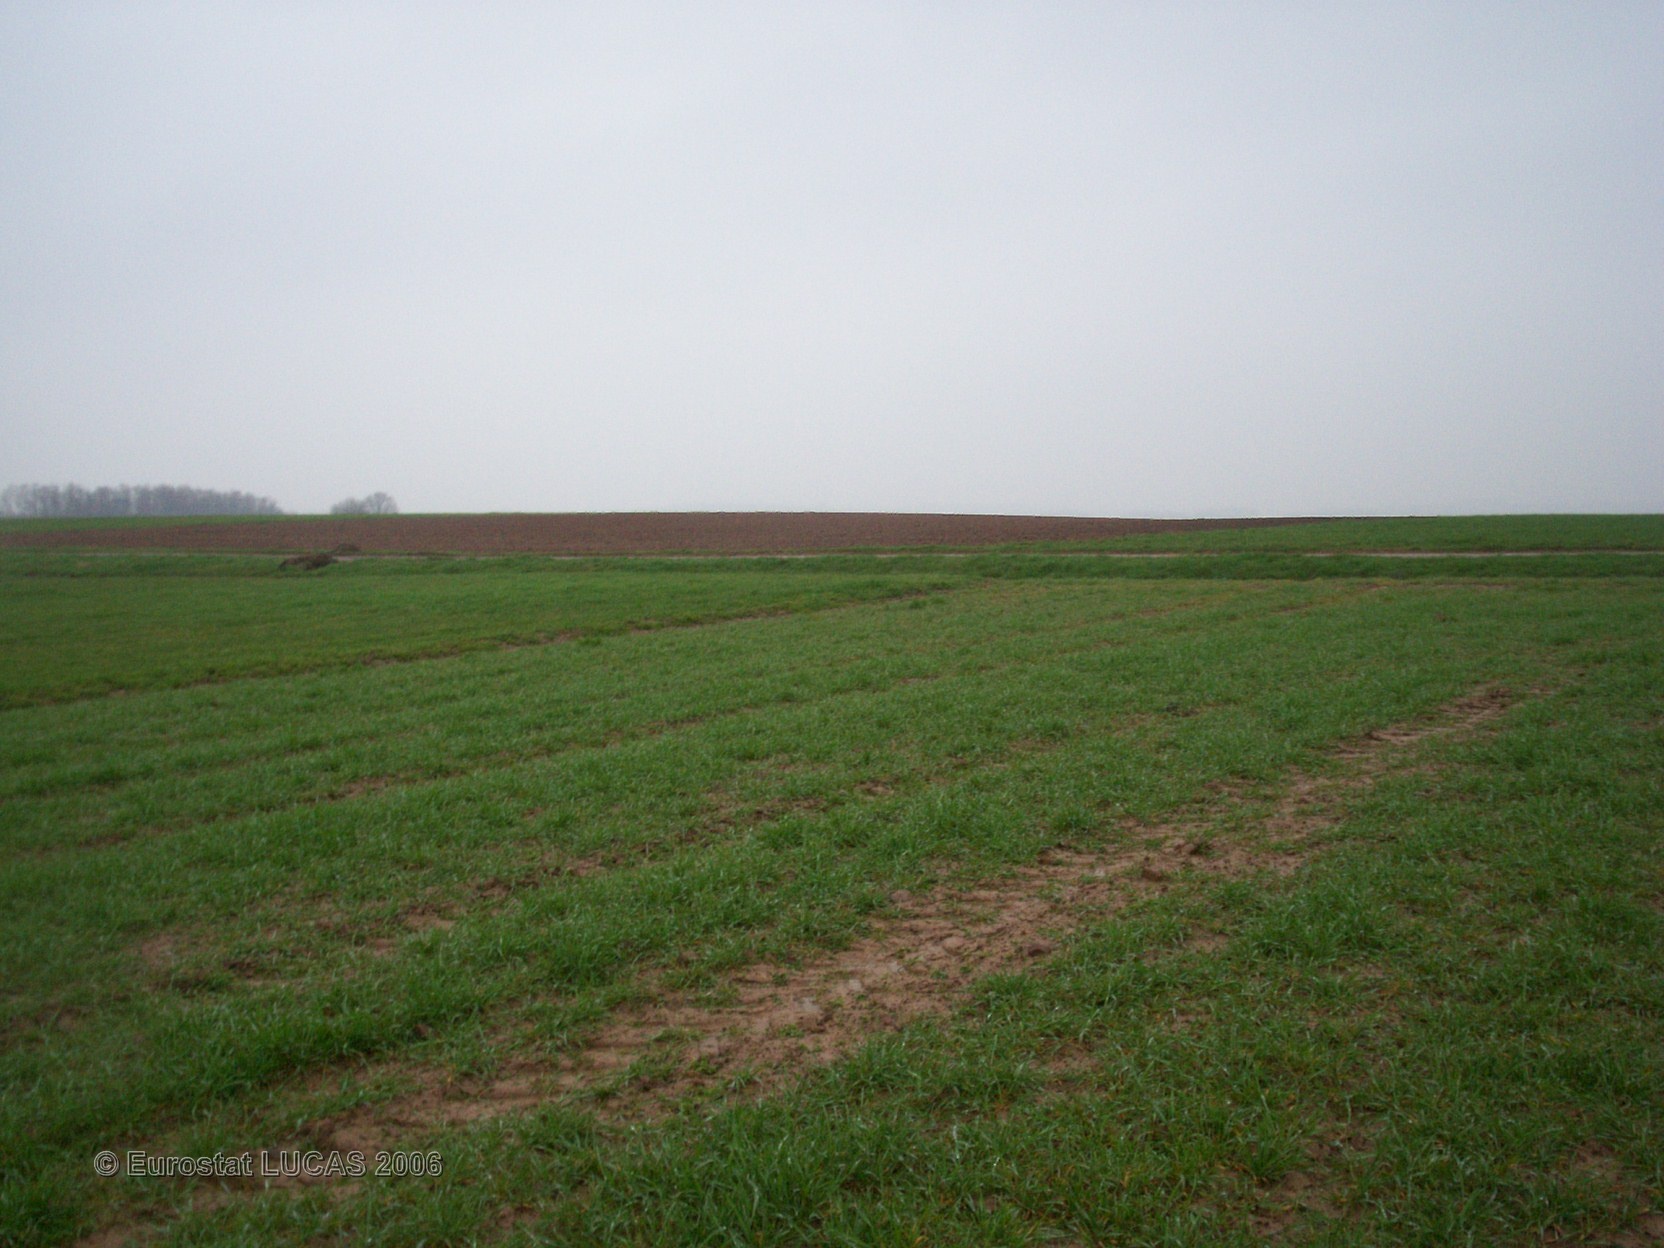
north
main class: Cropland
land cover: Common wheat
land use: Agriculture (excluding fallow land and kitchen gardens)
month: April
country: FR
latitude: 48.1238
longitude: 6.2524
